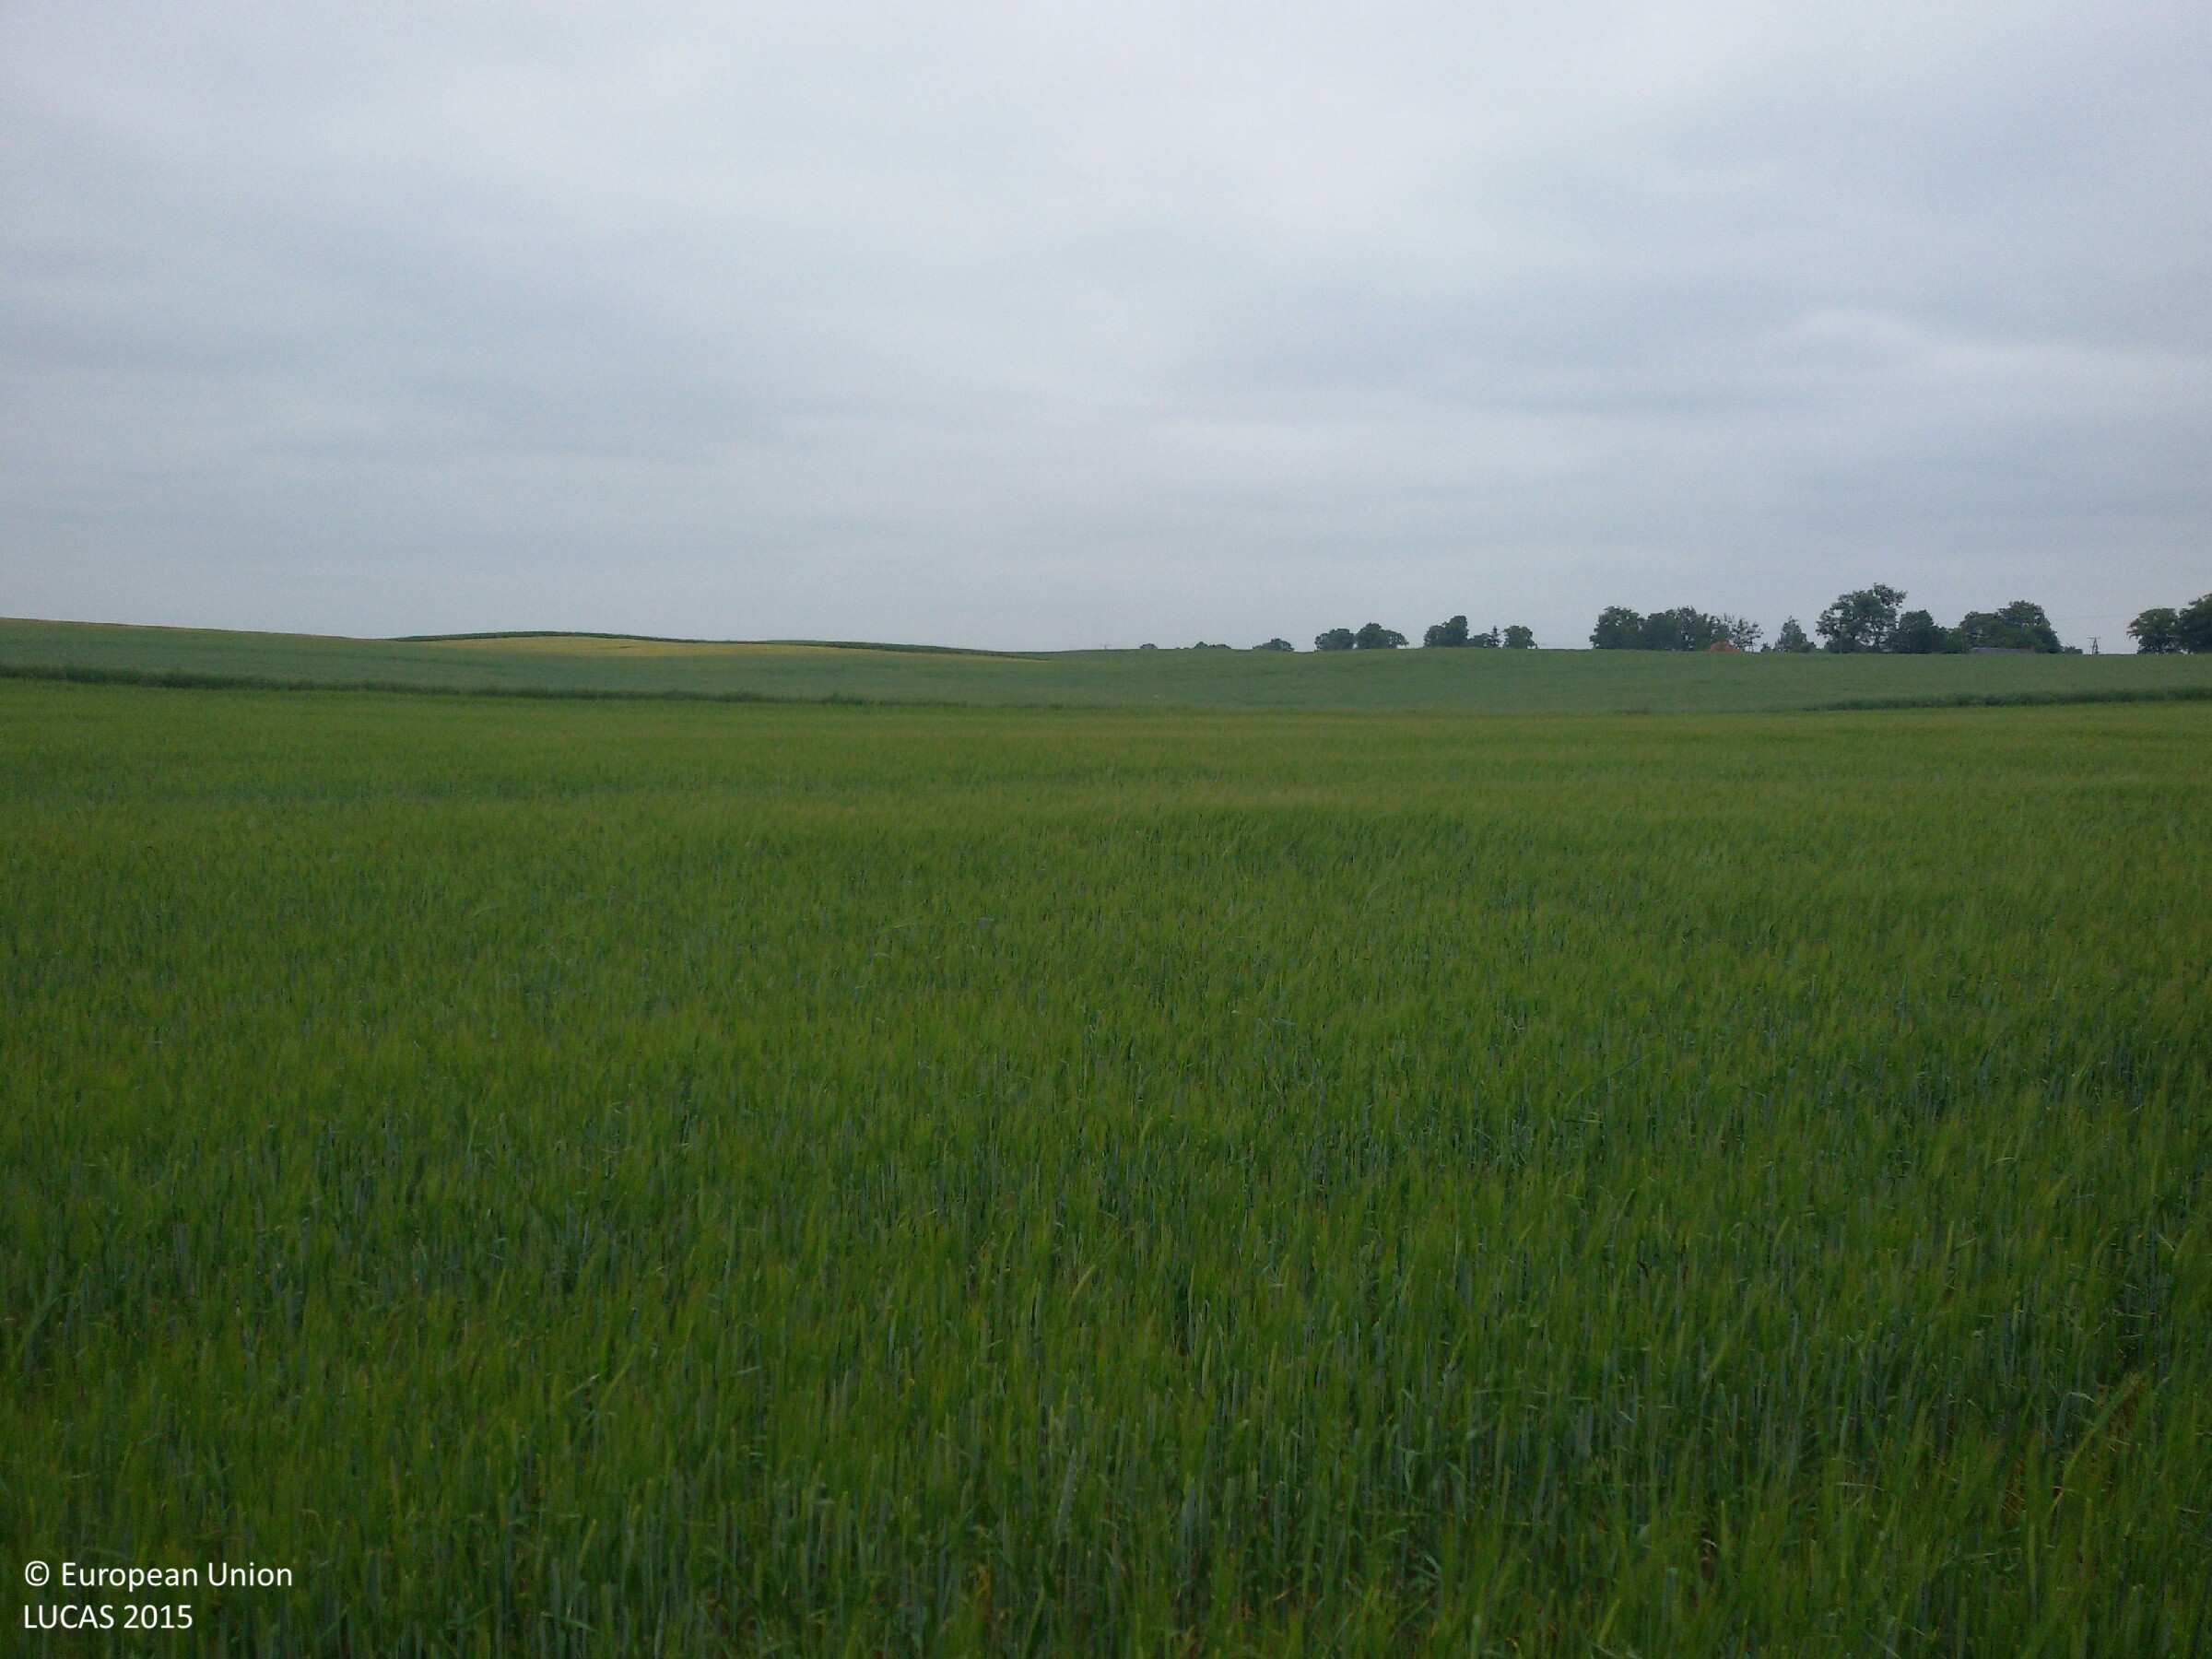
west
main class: Cropland
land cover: Barley
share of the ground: > 75 %
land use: Agriculture (excluding fallow land and kitchen gardens)
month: June
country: PL
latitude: 53.5009
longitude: 19.2356
